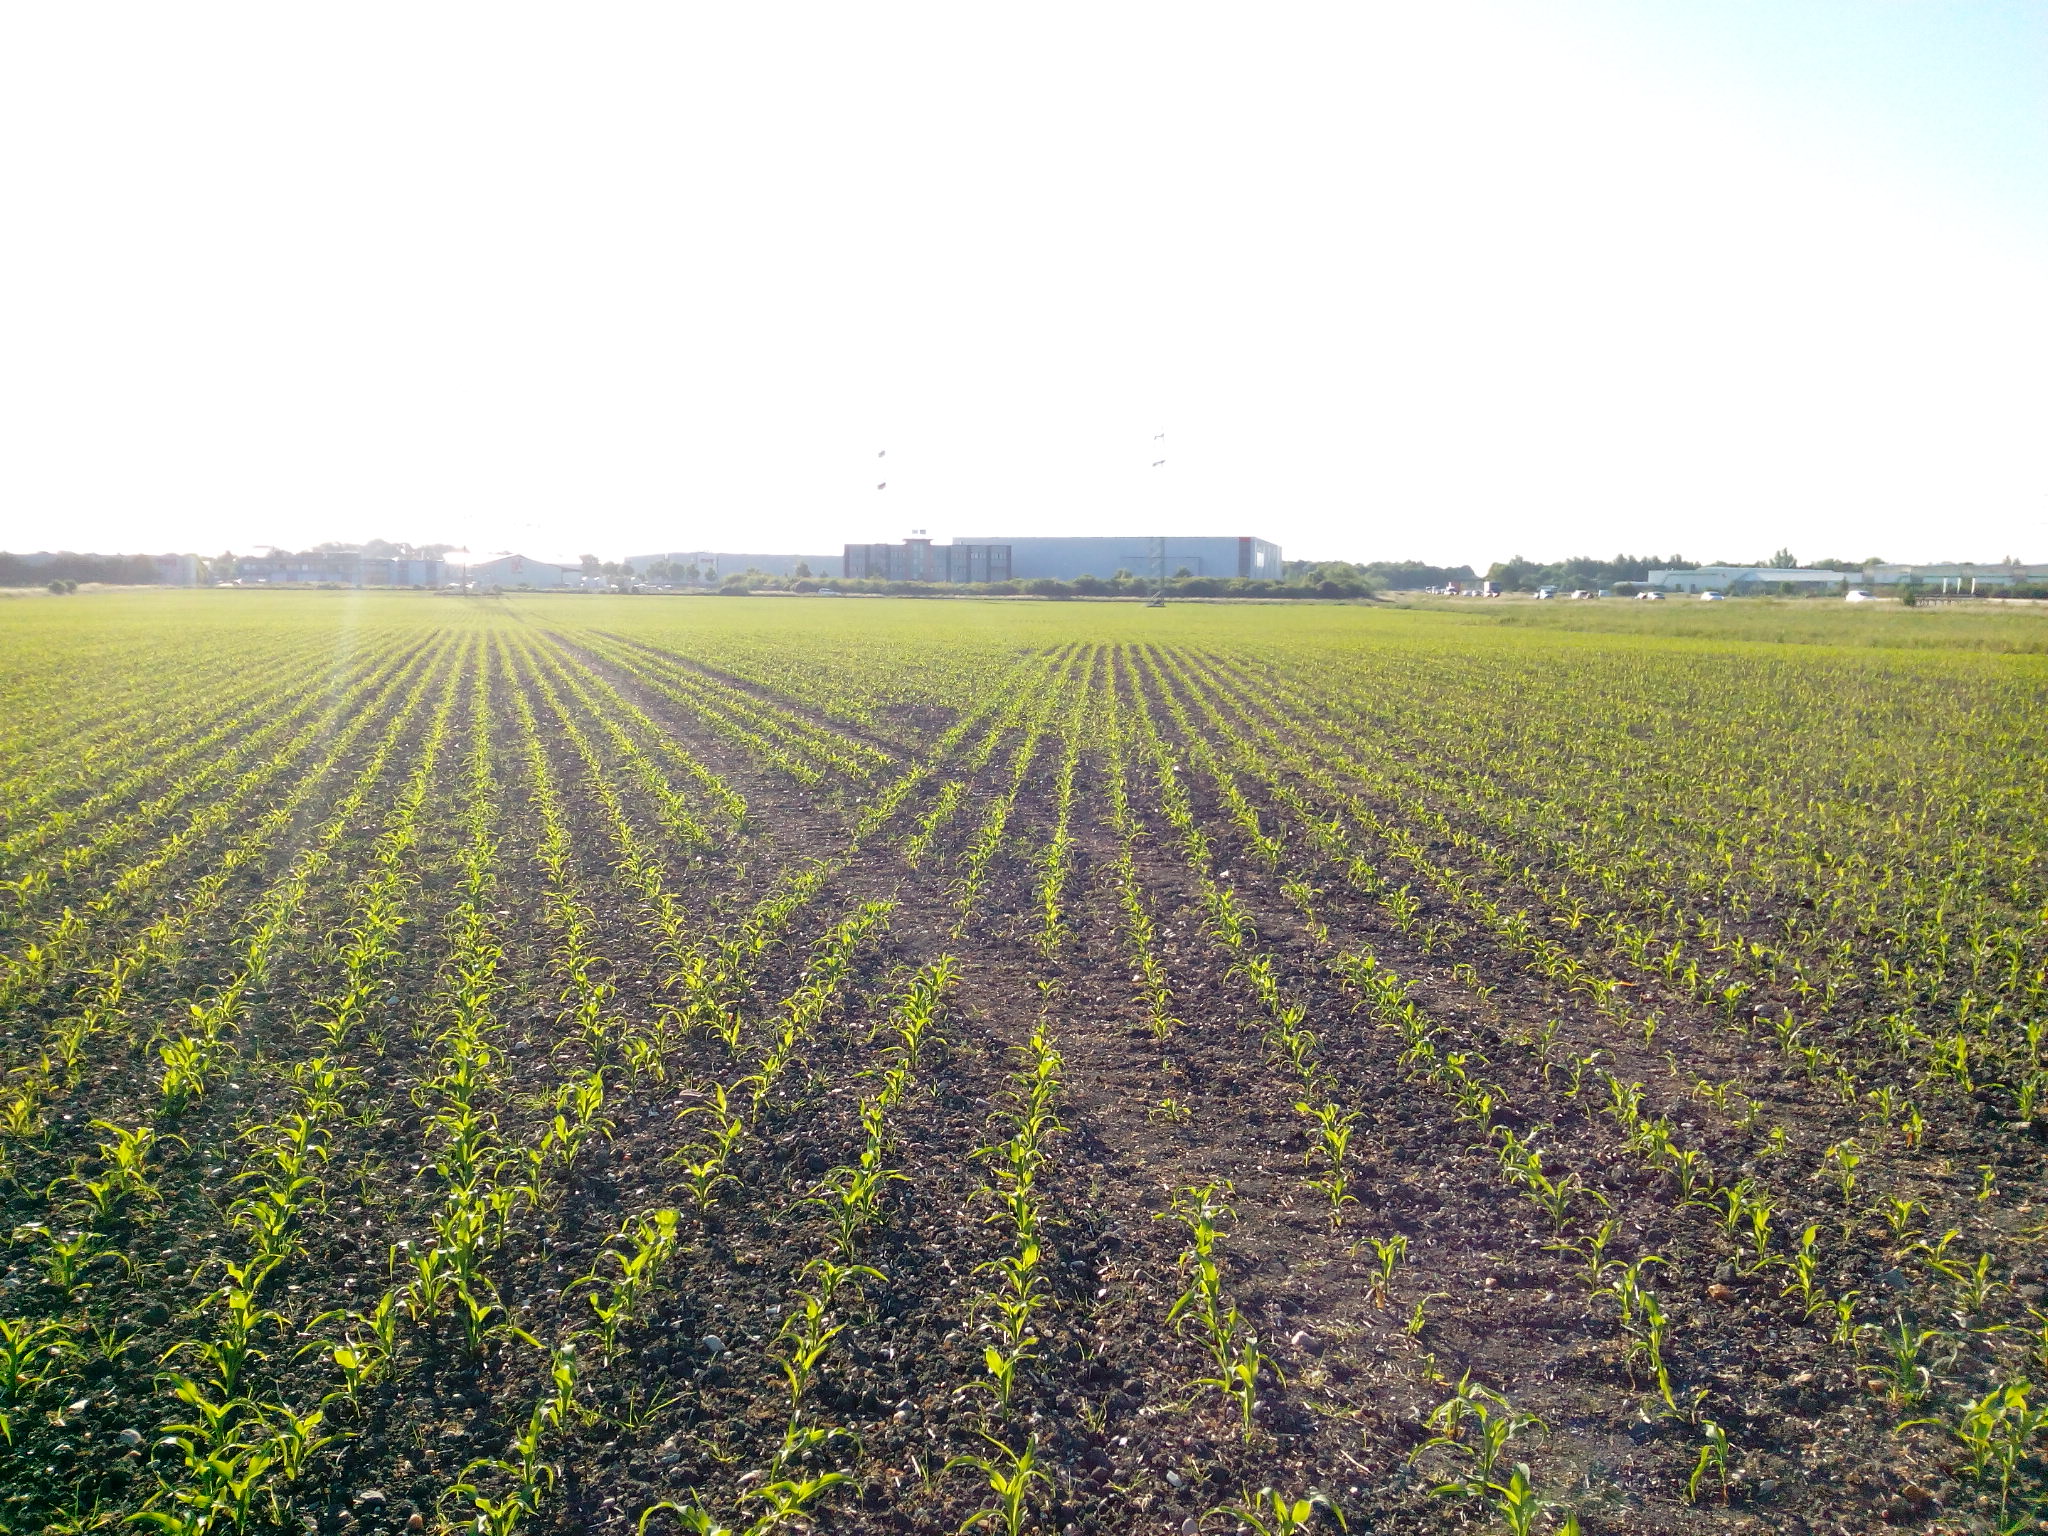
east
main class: Cropland
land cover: Maize
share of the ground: 10 - 25 %
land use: Agriculture (excluding fallow land and kitchen gardens)
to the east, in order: Maize; Electric lines
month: June
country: DE
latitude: 52.3594
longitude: 9.8973
